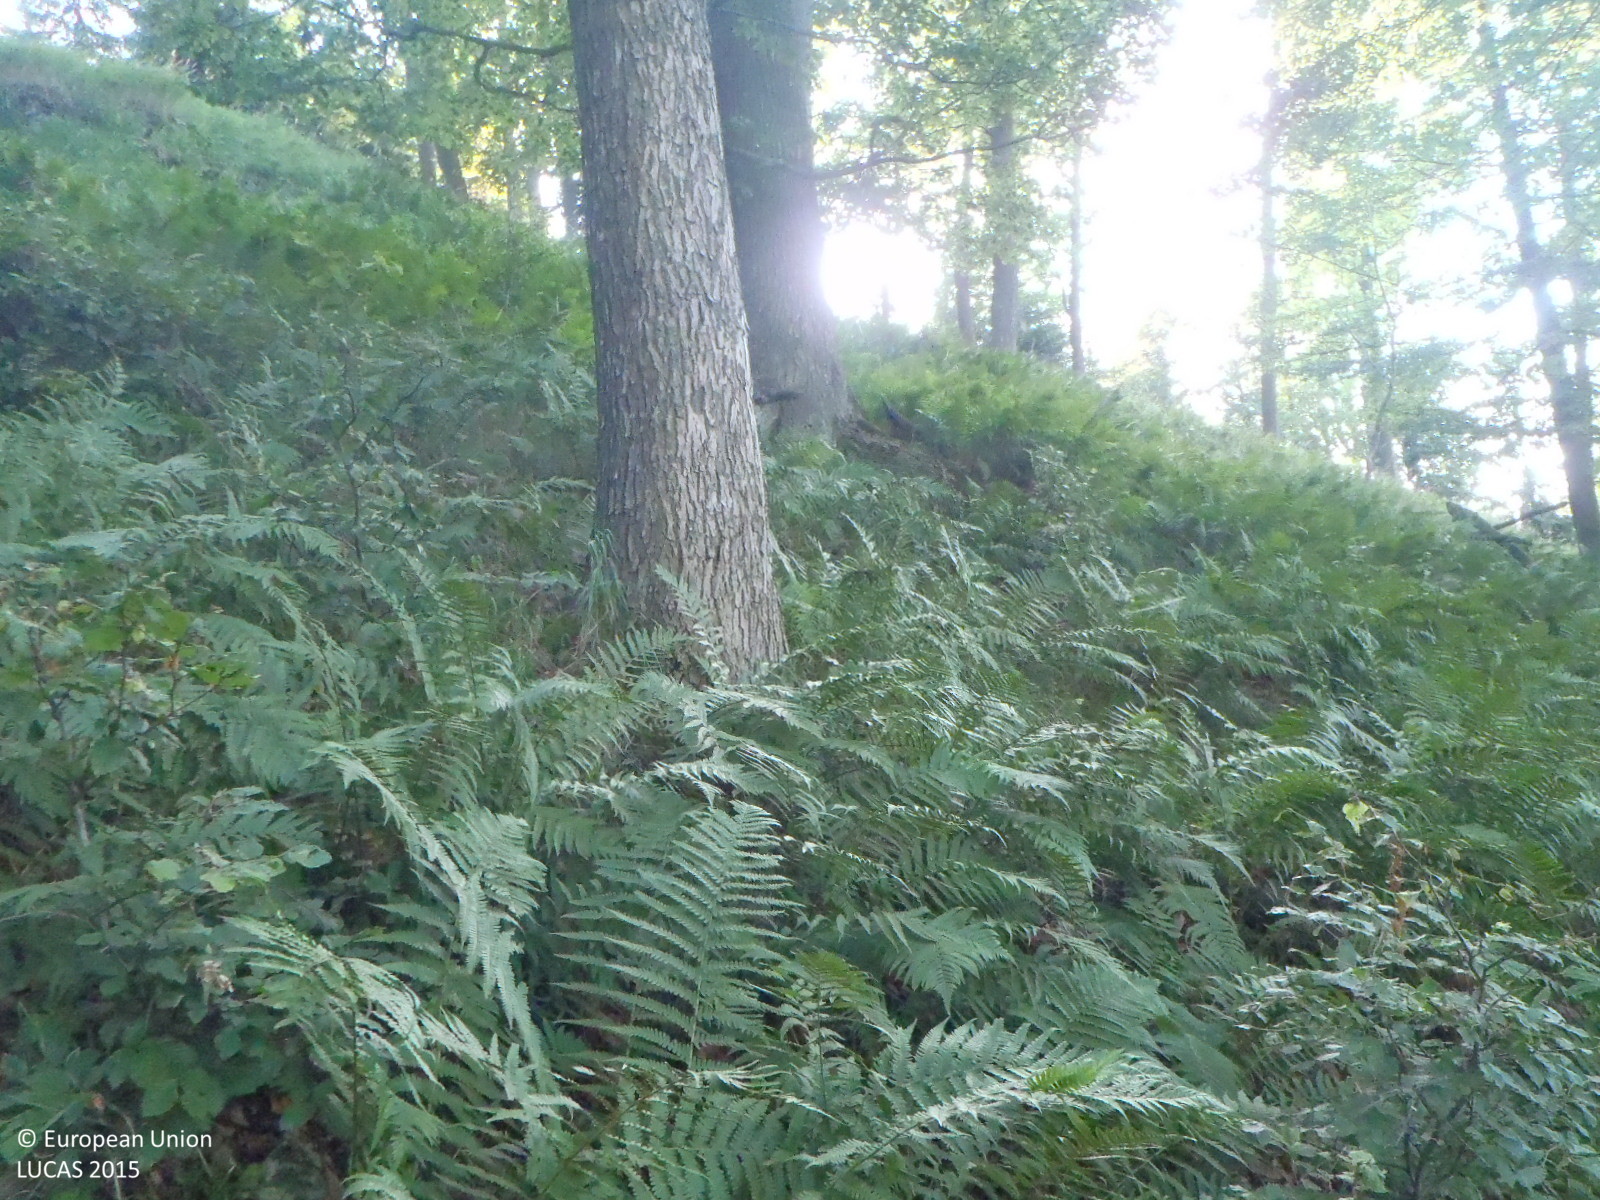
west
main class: Woodland
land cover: Broadleaved woodland
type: beech forest
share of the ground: > 75 %
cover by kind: broadleaved forest trees 95 %, herbaceous plants 5 %
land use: Forestry
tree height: > 5 m
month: August
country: CZ
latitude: 50.7956
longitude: 14.5561
